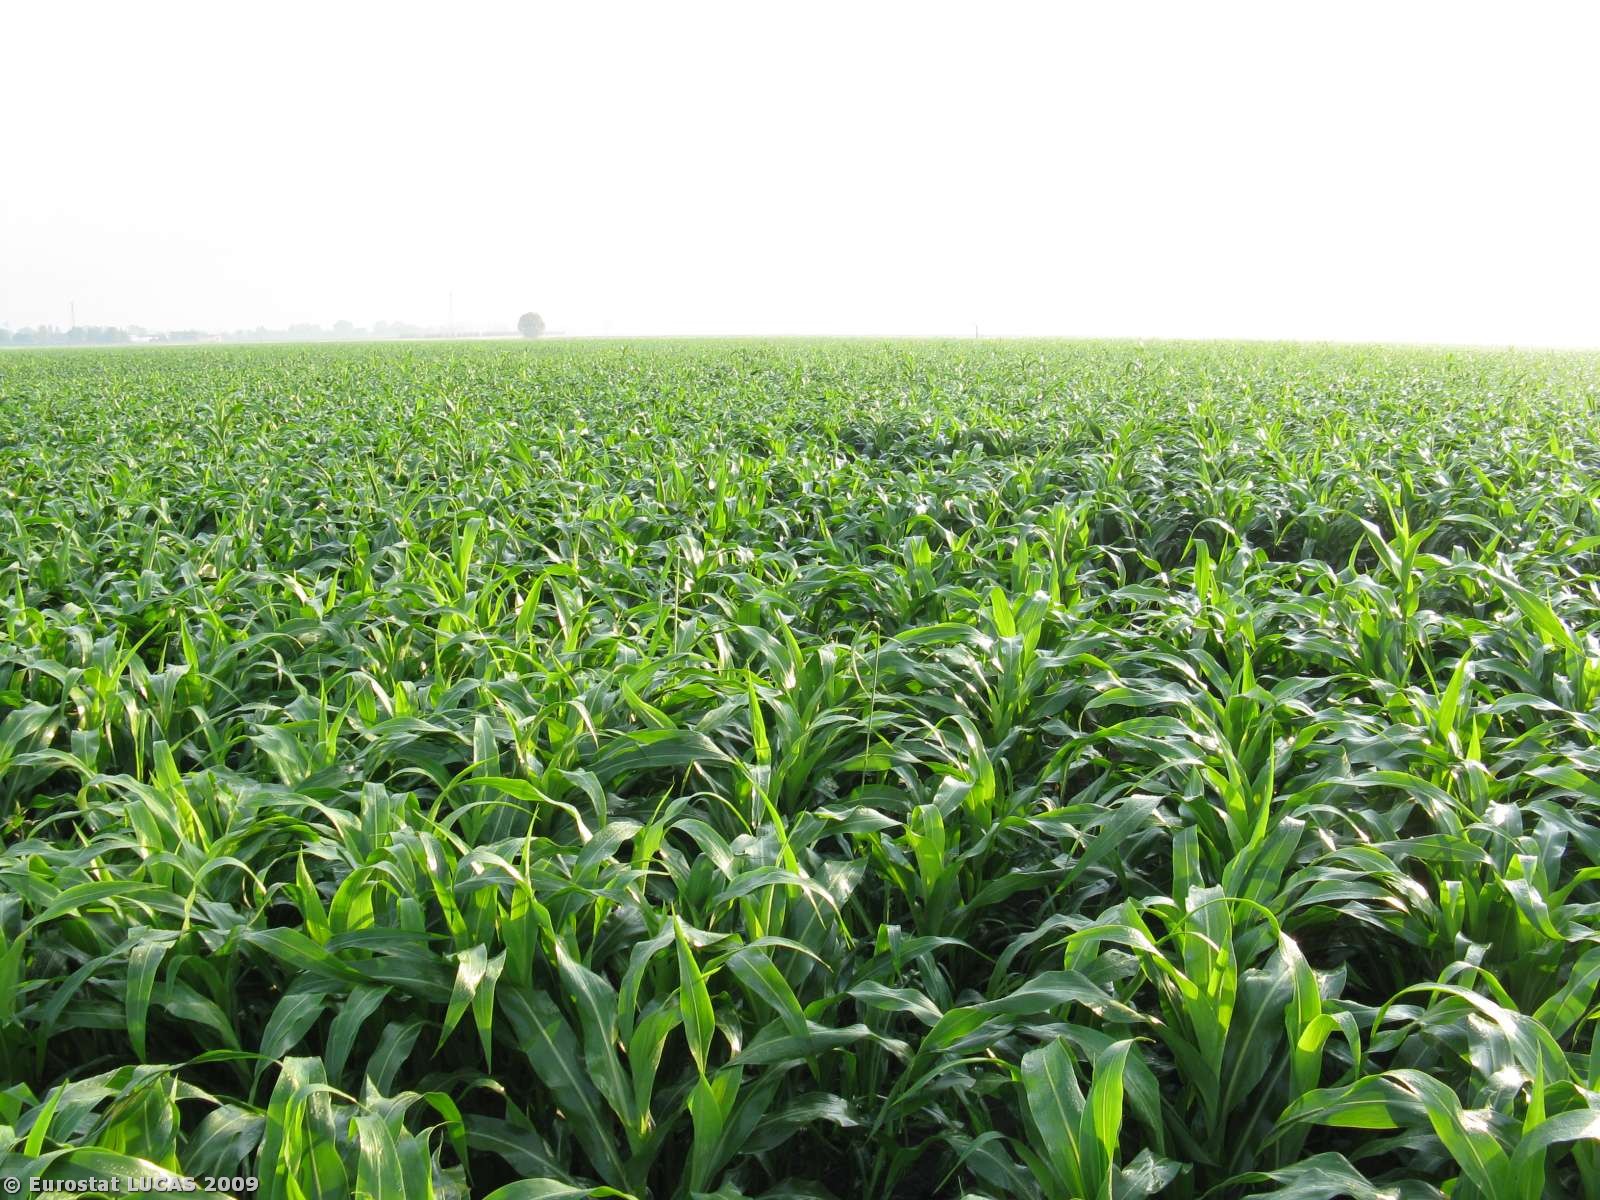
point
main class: Cropland
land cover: Other cereals
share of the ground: > 75 %
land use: Agriculture (excluding fallow land and kitchen gardens)
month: July
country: IT
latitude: 44.7695
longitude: 11.7024
